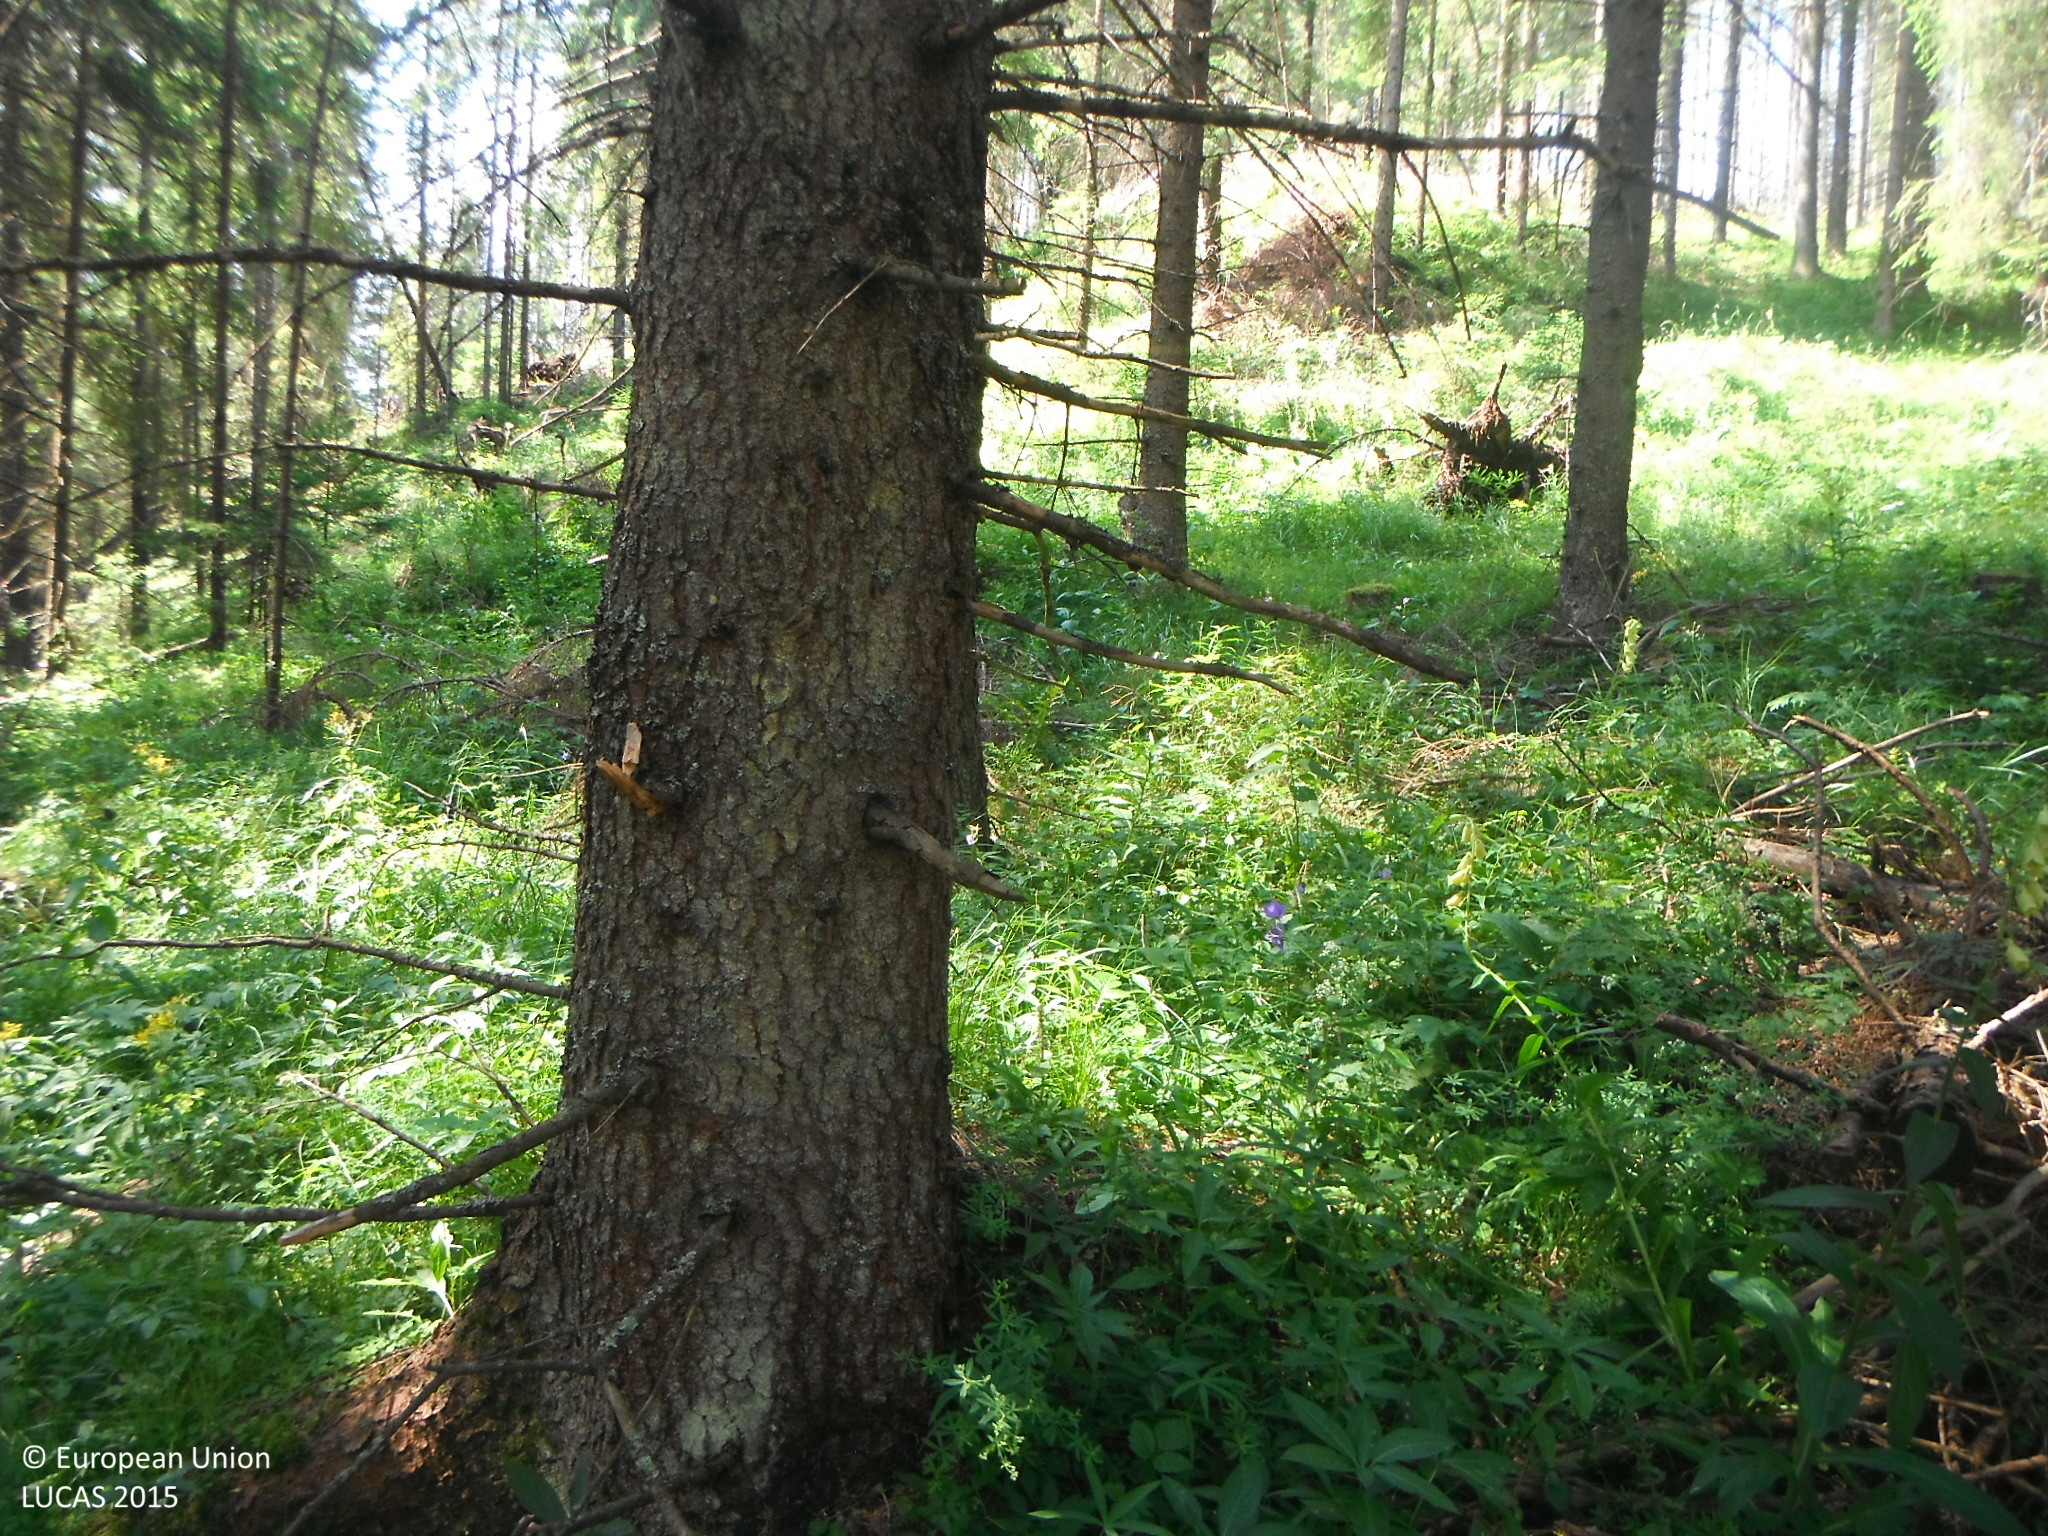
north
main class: Woodland
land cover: Spruce dominated coniferous woodland
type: alpine coniferous forest
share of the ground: > 75 %
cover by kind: coniferous forest trees 100 %
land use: Forestry
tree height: > 5 m
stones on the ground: > 50 %
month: July
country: SK
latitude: 49.2861
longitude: 20.2486
